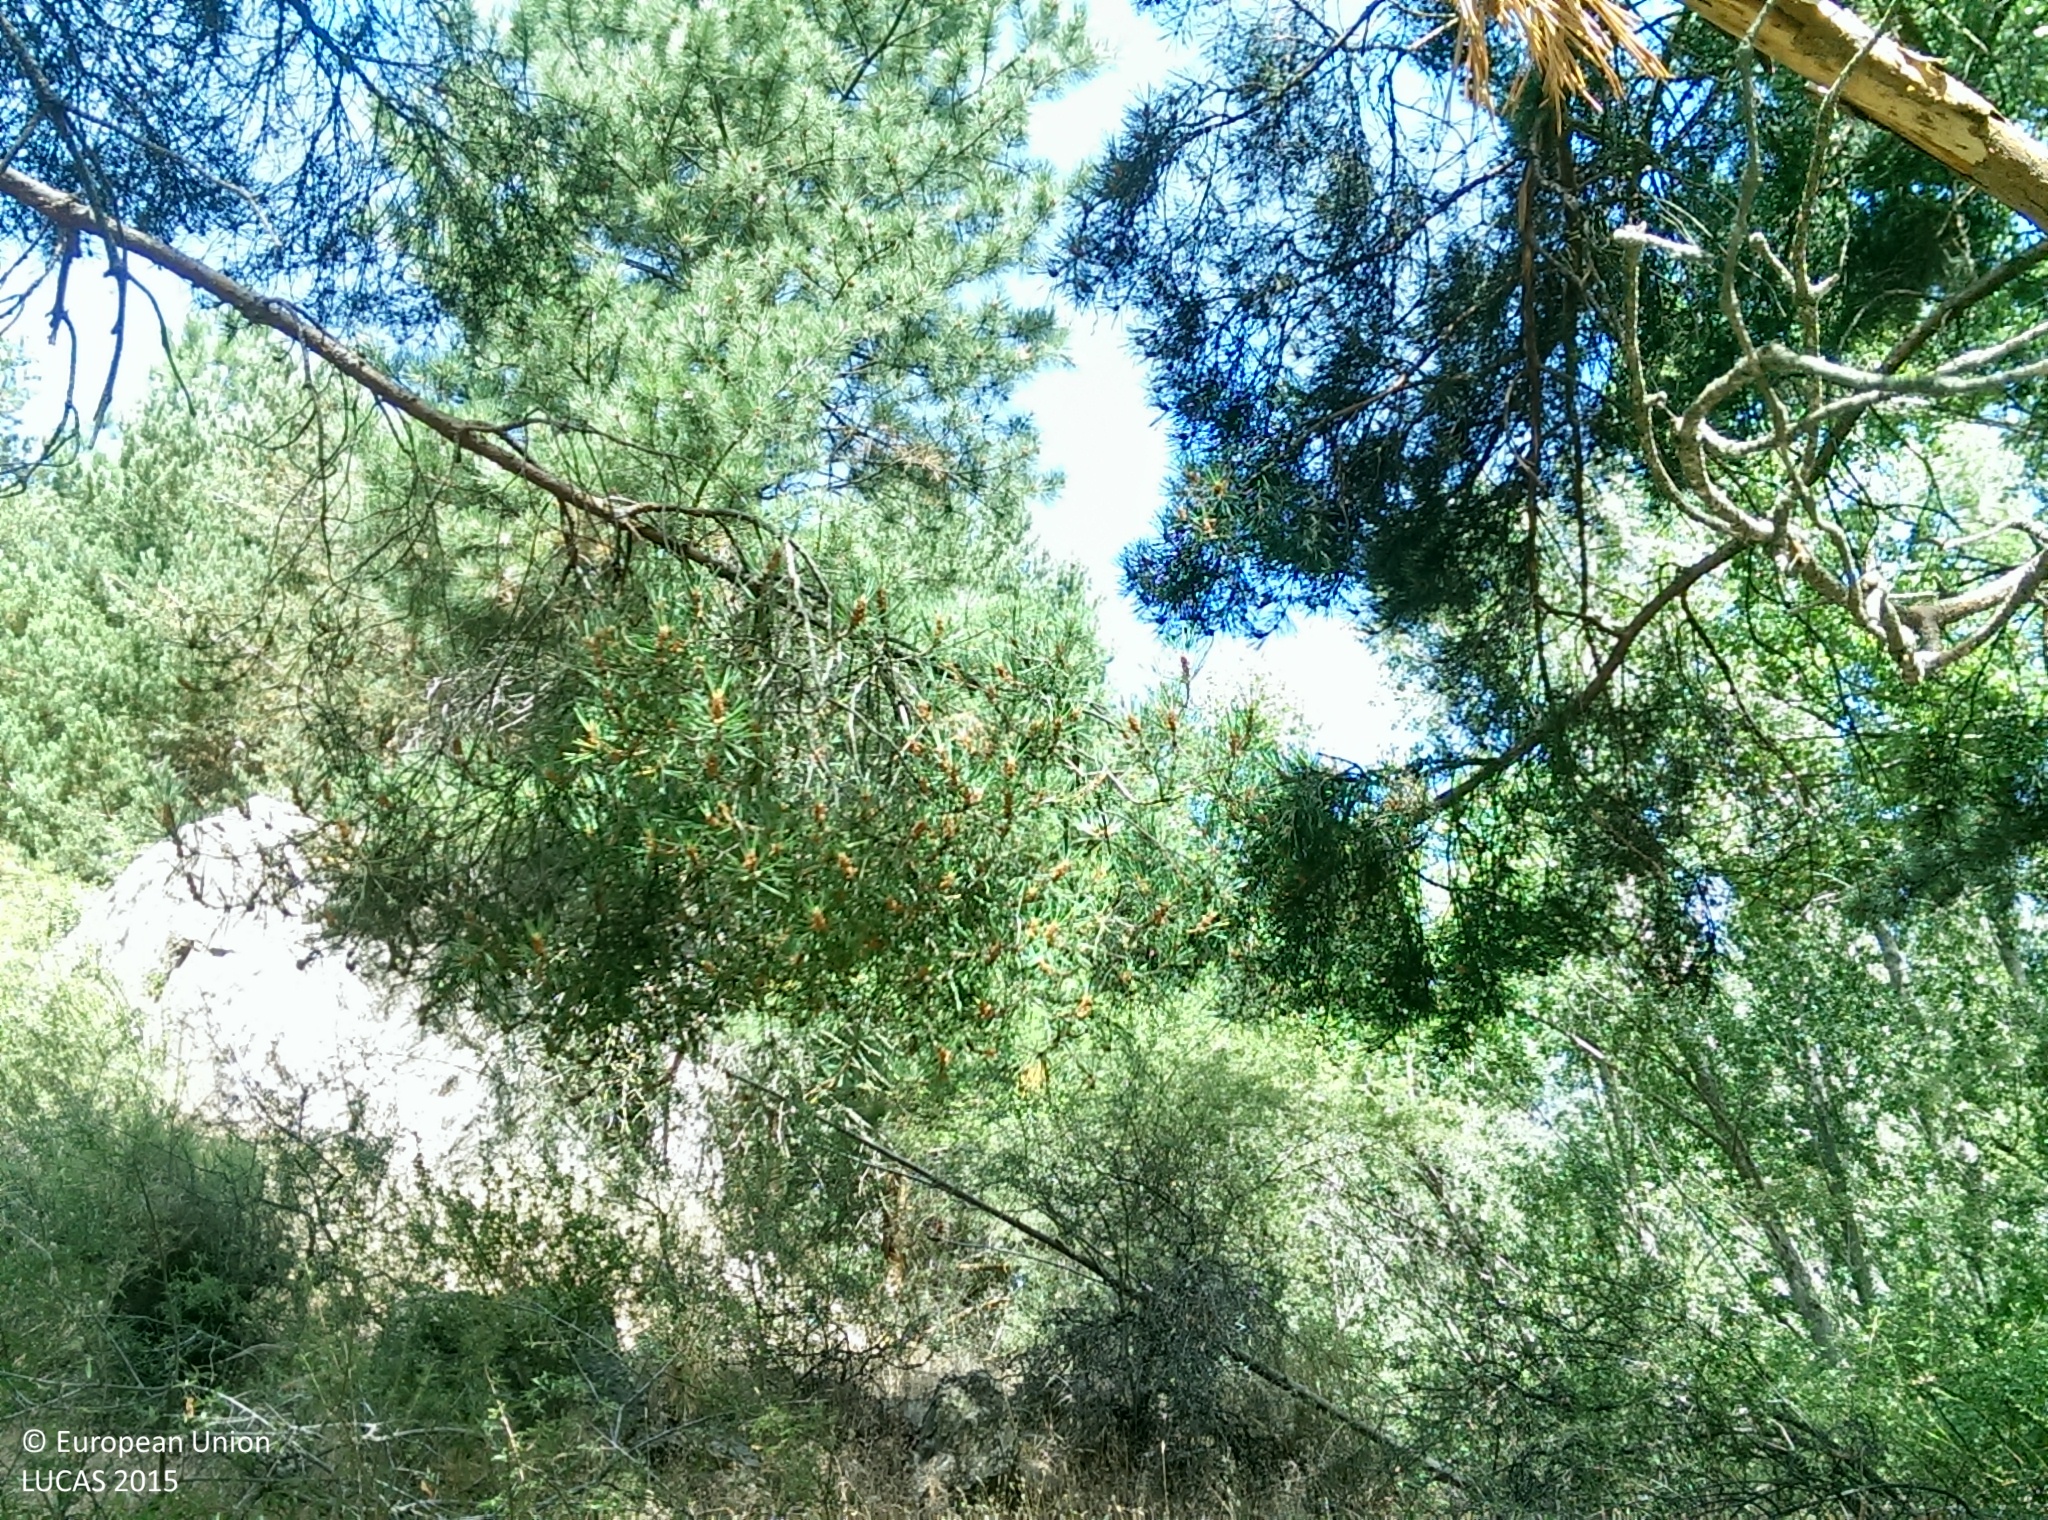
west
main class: Woodland
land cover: Pine dominated coniferous woodland
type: coniferous forest of the mediterranean region
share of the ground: > 75 %
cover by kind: coniferous forest trees 70 %, broadleaved forest trees 10 %, shrubs 10 %, herbaceous plants 5 %, unconsolidated bare surface 5 %
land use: Forestry
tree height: > 5 m
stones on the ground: 25 - 50 %
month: July
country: ES
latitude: 37.1512
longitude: -3.2151
